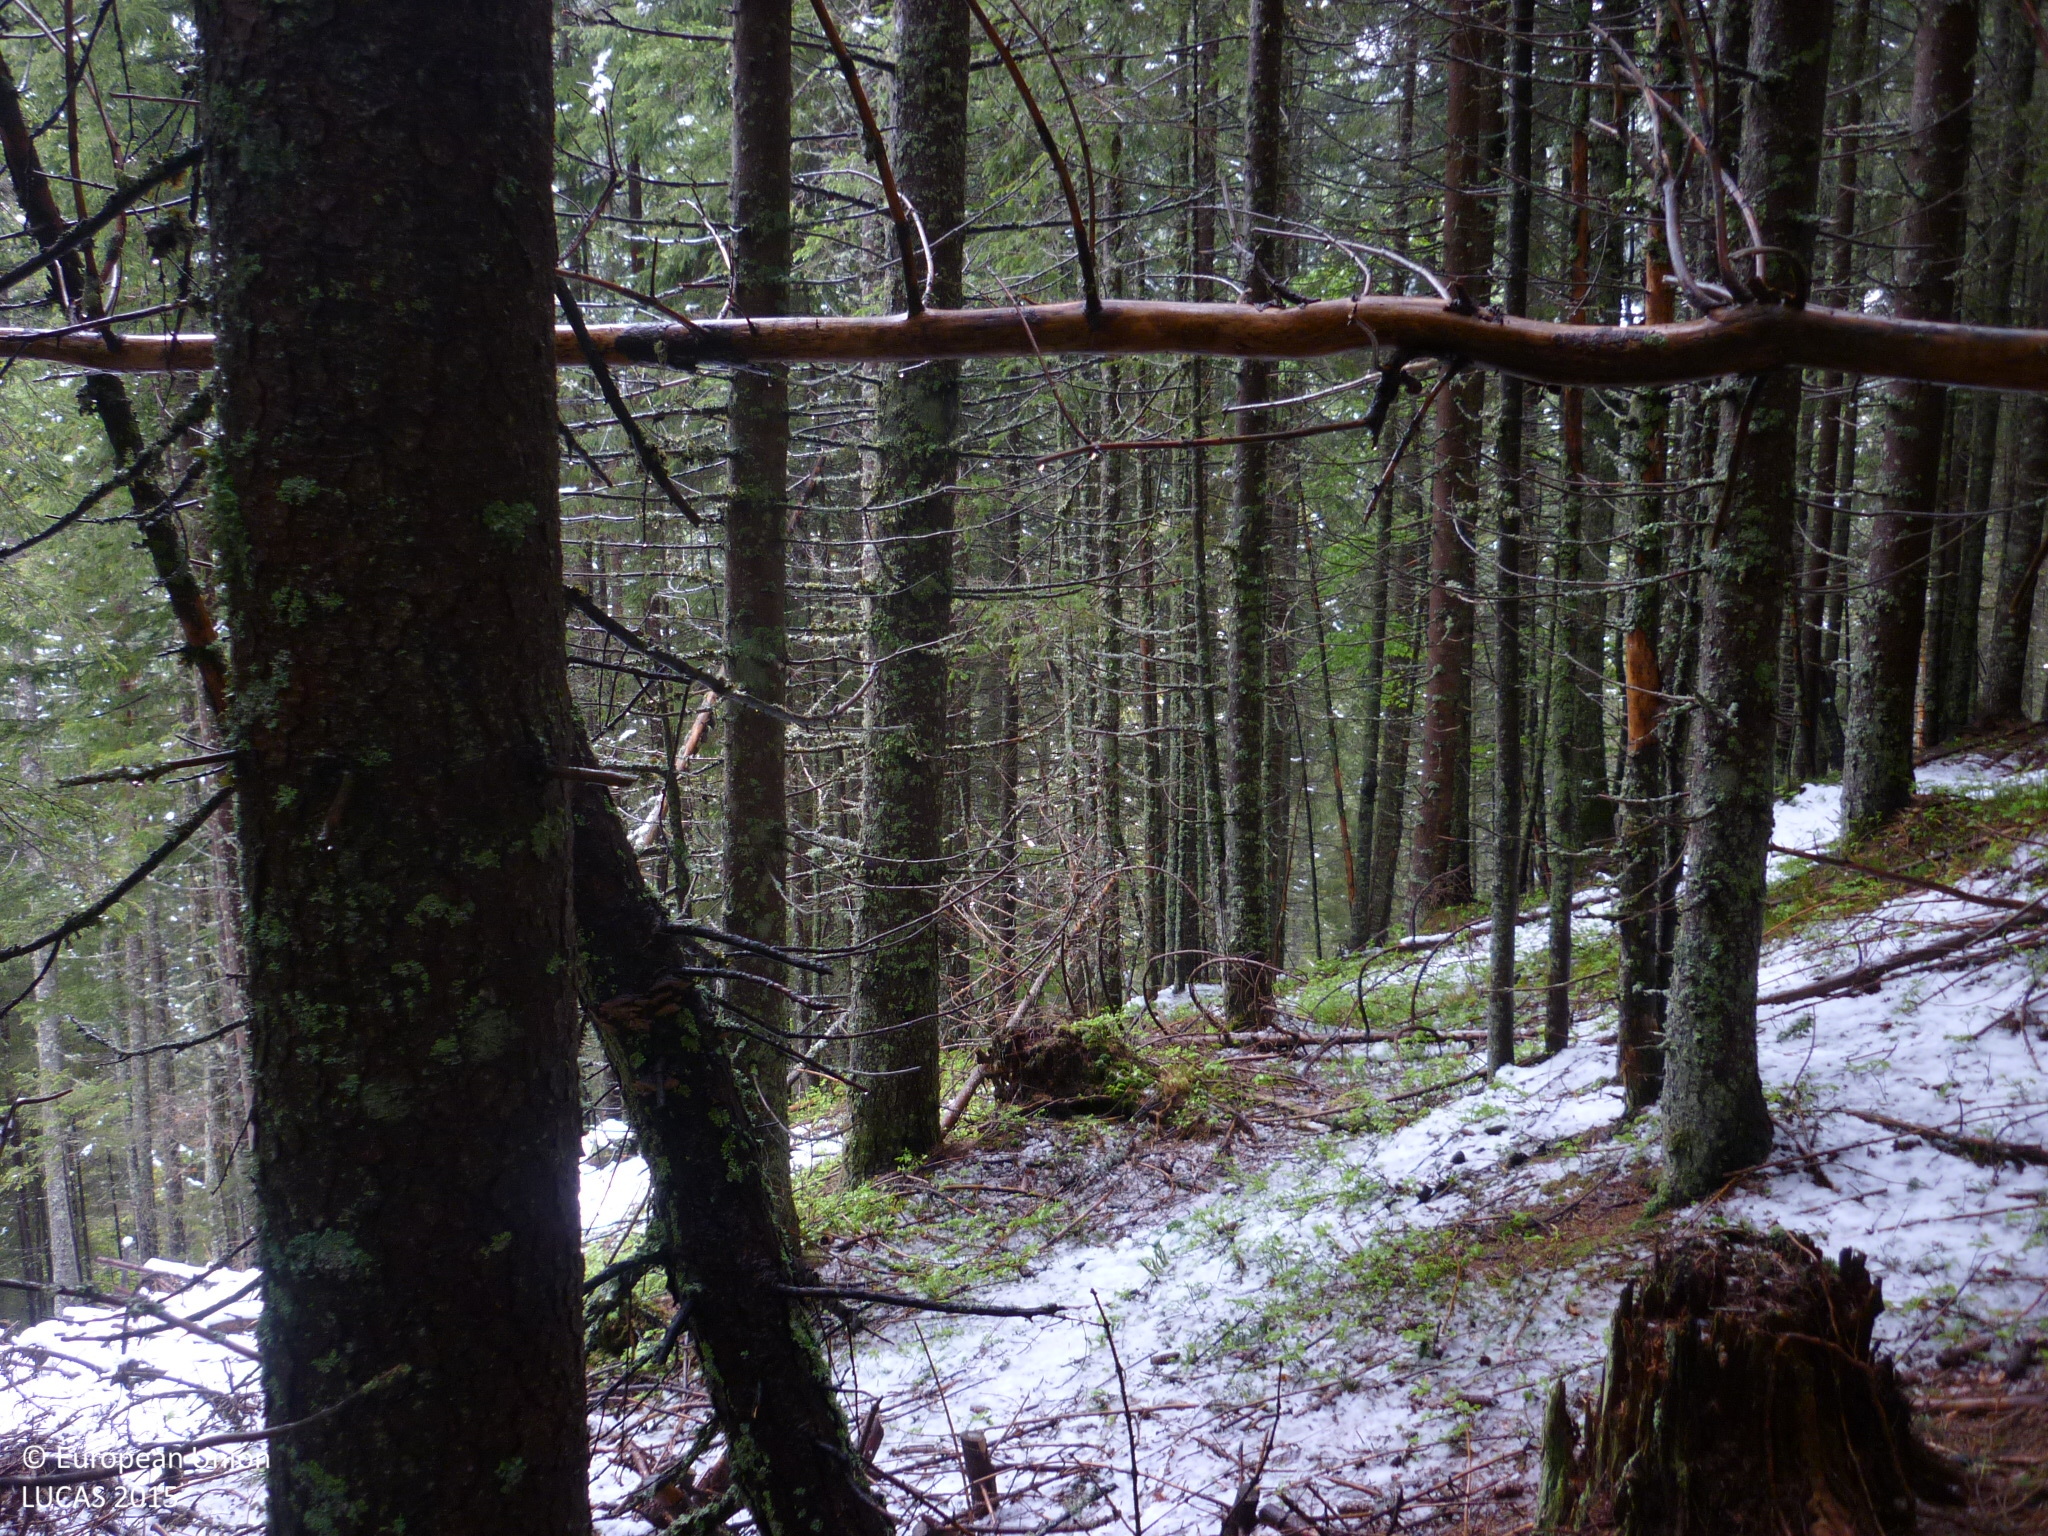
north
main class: Woodland
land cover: Spruce dominated coniferous woodland
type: alpine coniferous forest
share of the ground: > 75 %
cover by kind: coniferous forest trees 95 %, lichens and mosses 5 %
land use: Forestry
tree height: > 5 m
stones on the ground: < 10 %
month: May
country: AT
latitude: 47.4268
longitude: 14.5462
